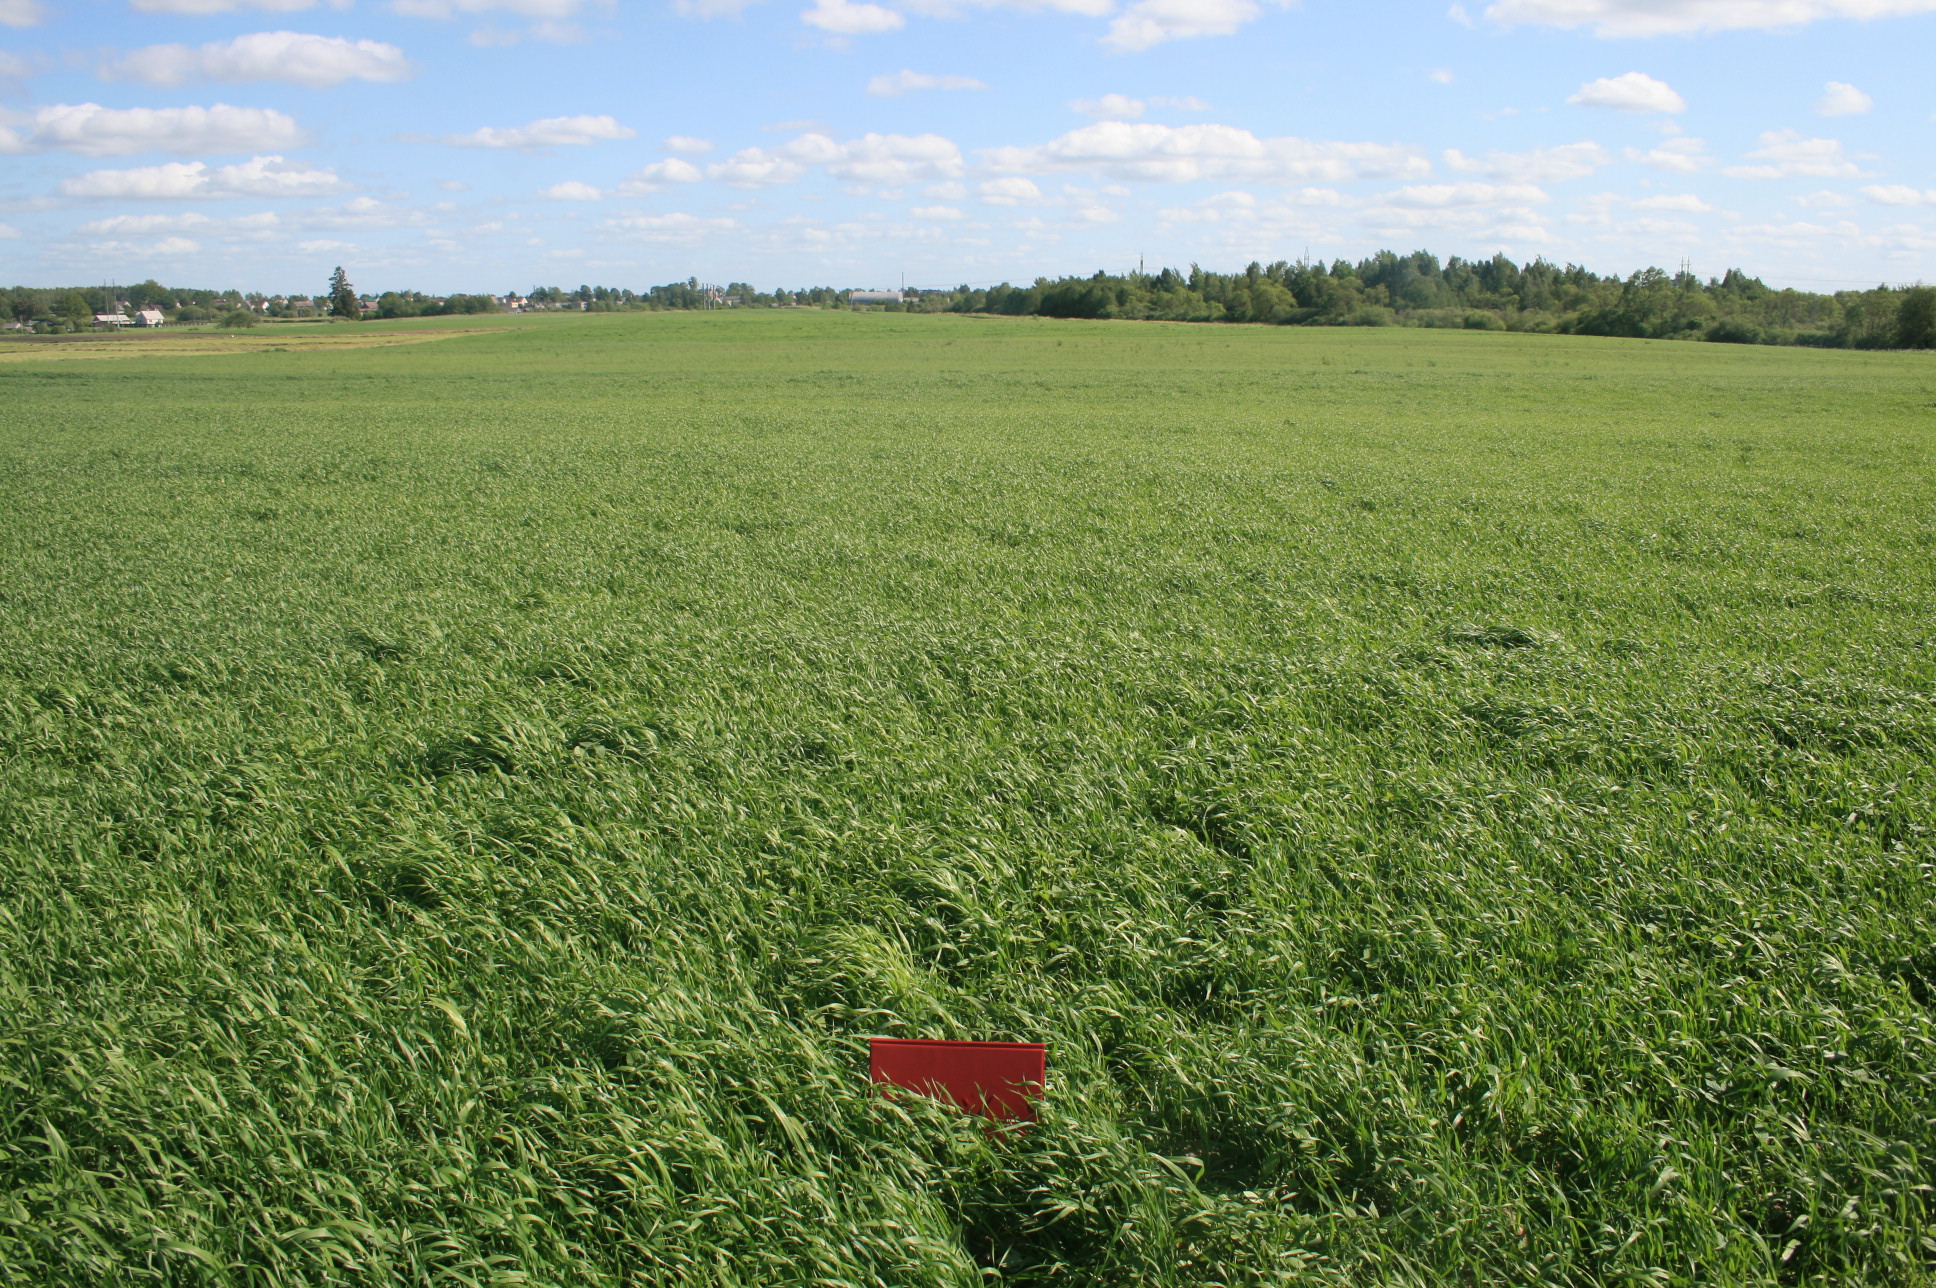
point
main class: Cropland
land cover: Common wheat
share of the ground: > 75 %
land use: Agriculture (excluding fallow land and kitchen gardens)
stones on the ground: < 10 %
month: June
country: LT
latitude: 56.0242
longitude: 22.3632
